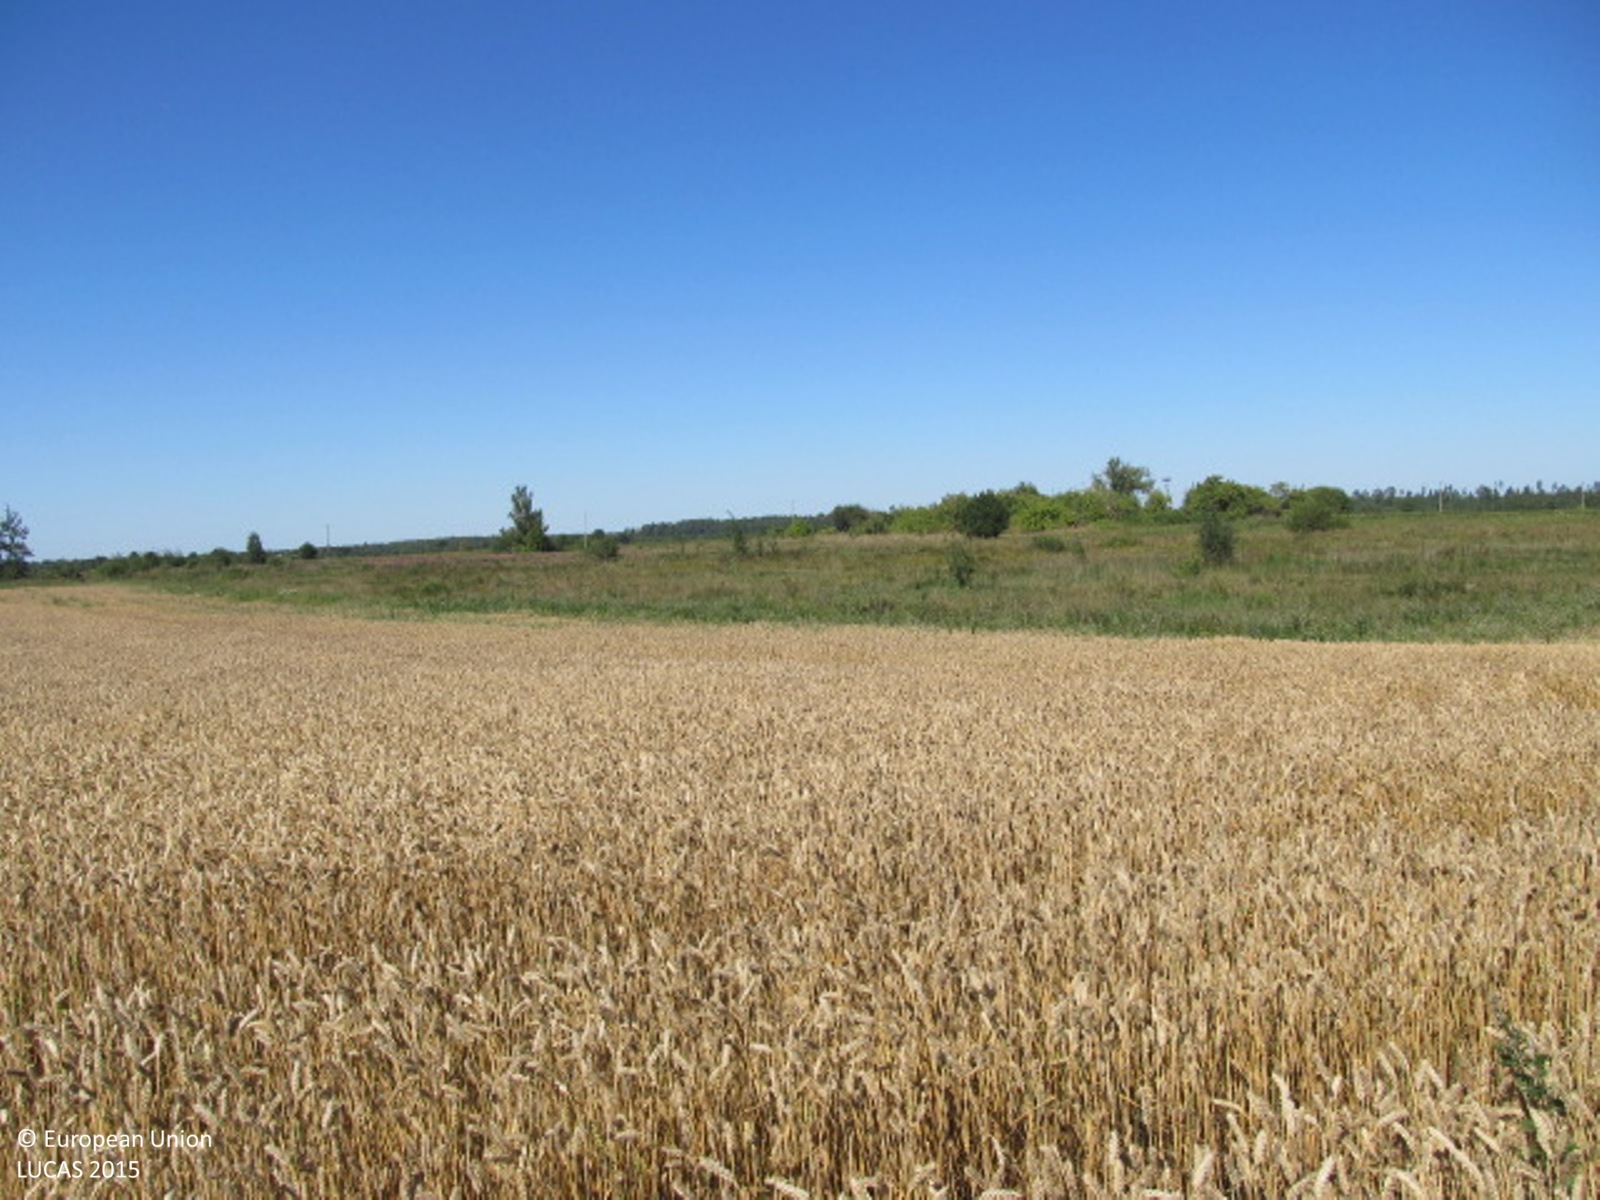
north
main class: Cropland
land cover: Common wheat
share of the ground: > 75 %
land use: Agriculture (excluding fallow land and kitchen gardens)
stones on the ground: < 10 %
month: August
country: LT
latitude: 56.1323
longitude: 22.5615
